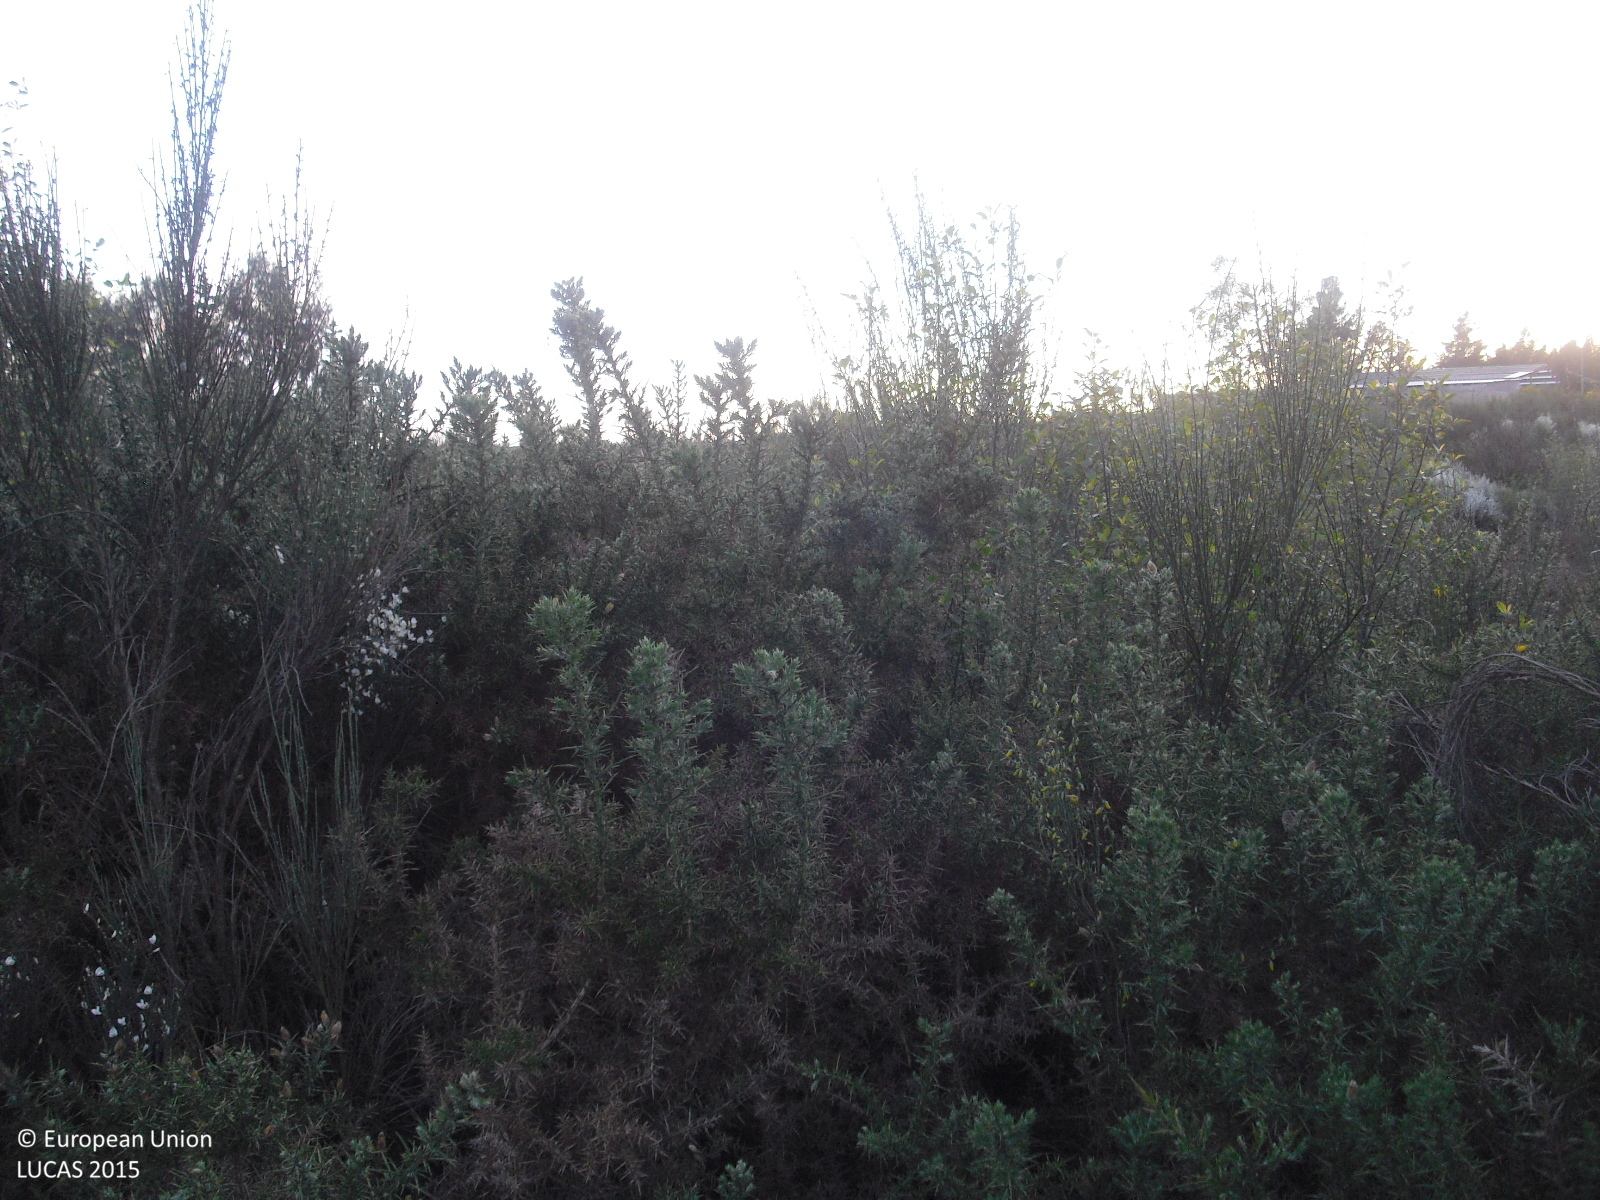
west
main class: Shrubland
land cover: Shrubland with sparse tree cover
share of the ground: > 75 %
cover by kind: shrubs 95 %, broadleaved forest trees 5 %
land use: Abandoned areas
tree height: < 5 m
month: May
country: ES
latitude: 41.9548
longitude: -7.3458
